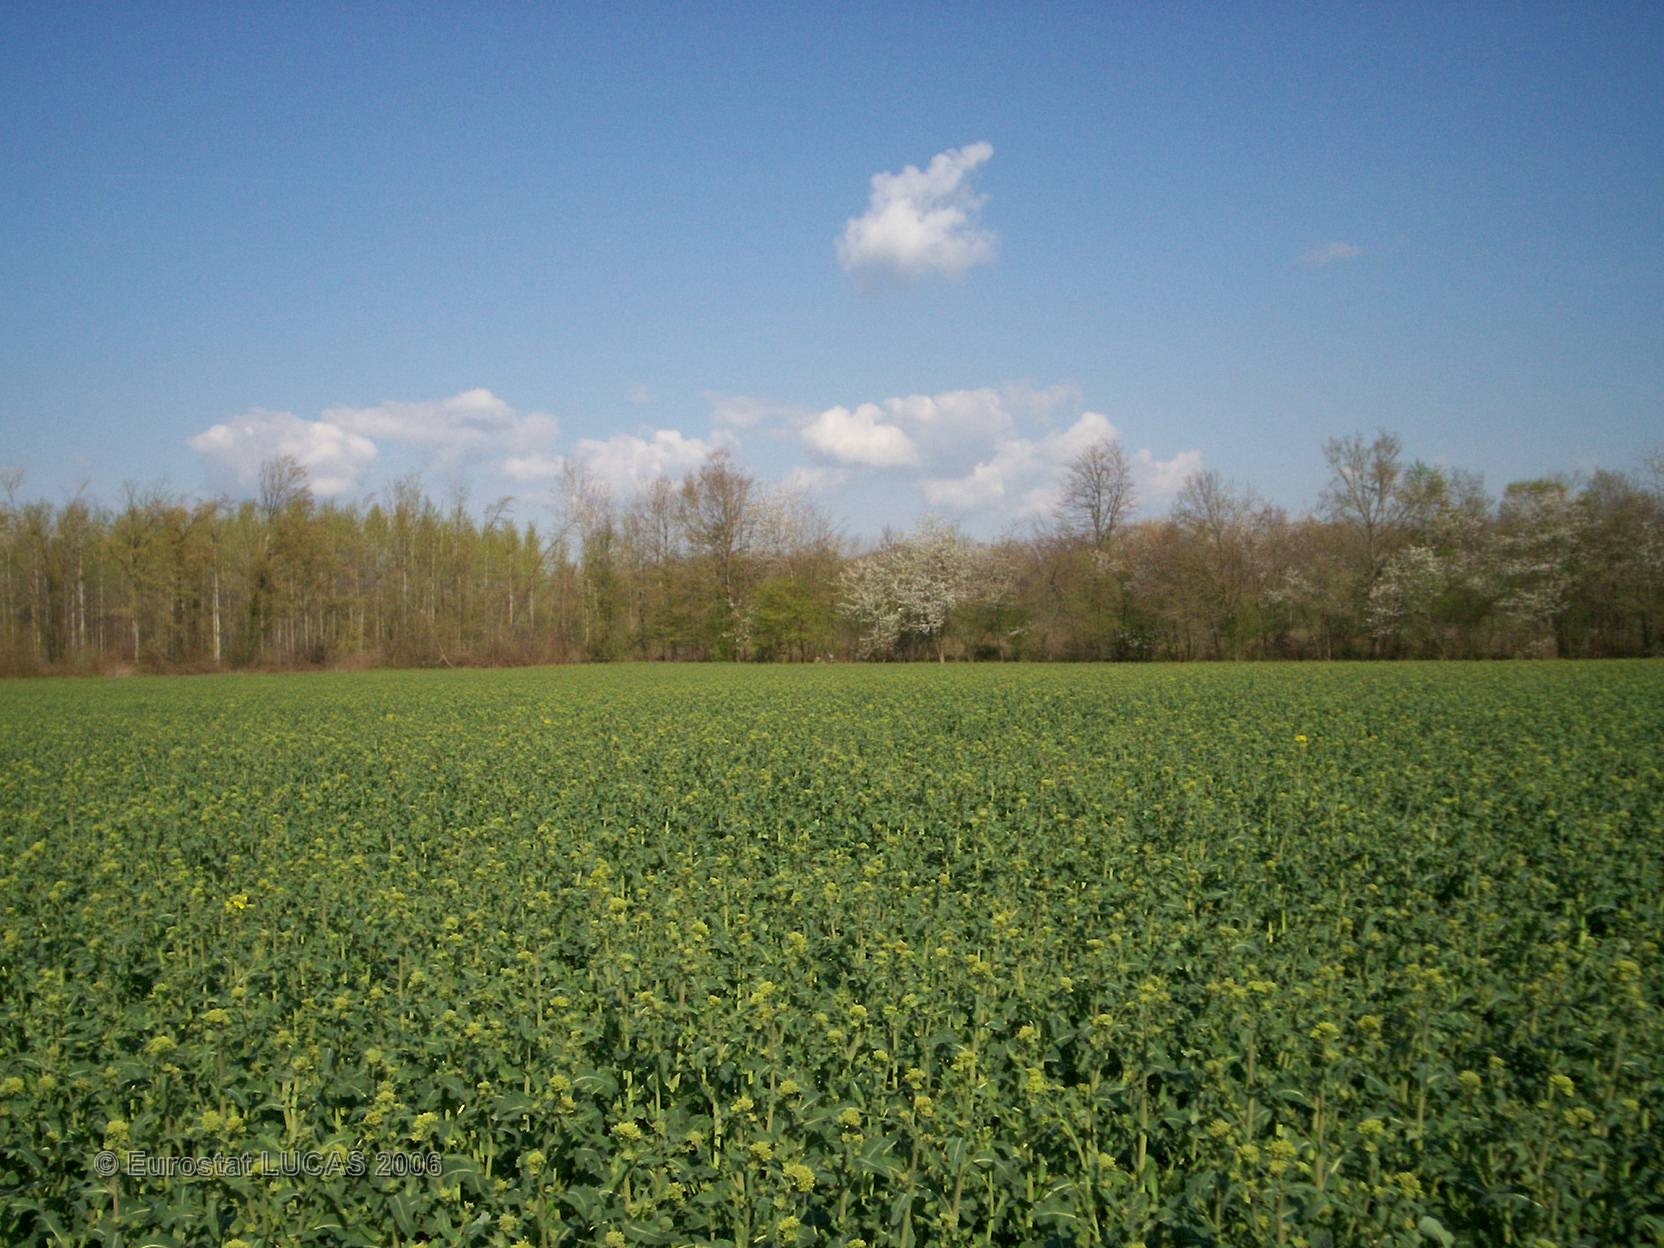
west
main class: Cropland
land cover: Rape and turnip rape
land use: Agriculture (excluding fallow land and kitchen gardens)
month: April
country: FR
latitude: 48.4081
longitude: 2.8720
